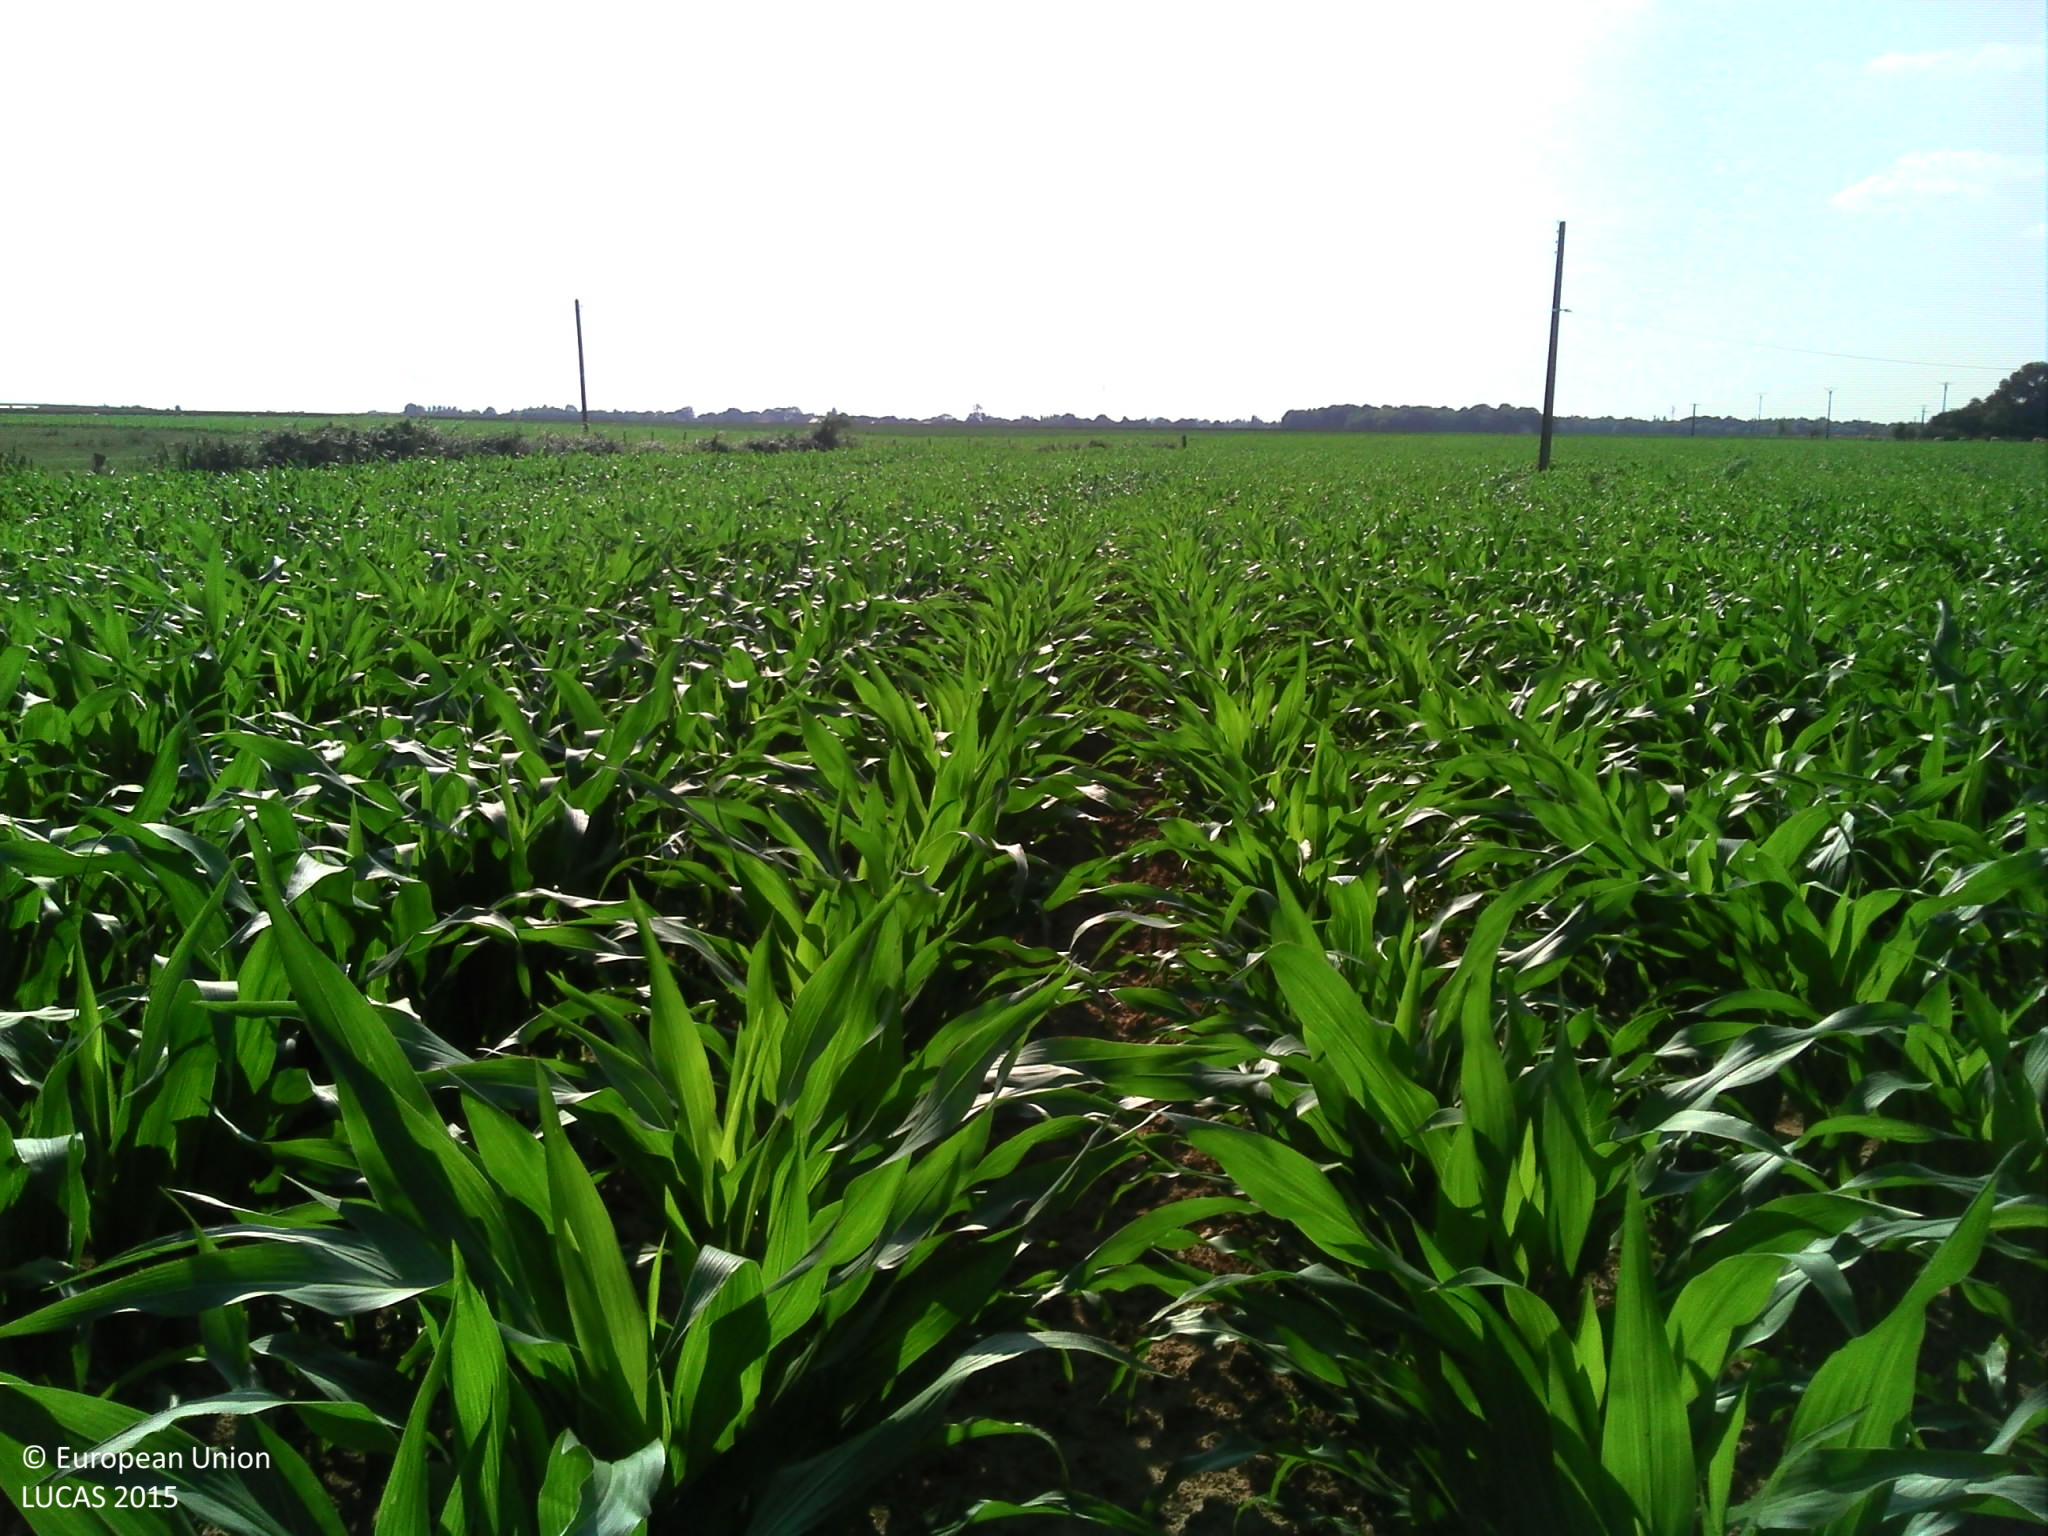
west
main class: Cropland
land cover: Maize
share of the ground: > 75 %
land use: Agriculture (excluding fallow land and kitchen gardens)
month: July
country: FR
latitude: 49.1689
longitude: 0.6902
